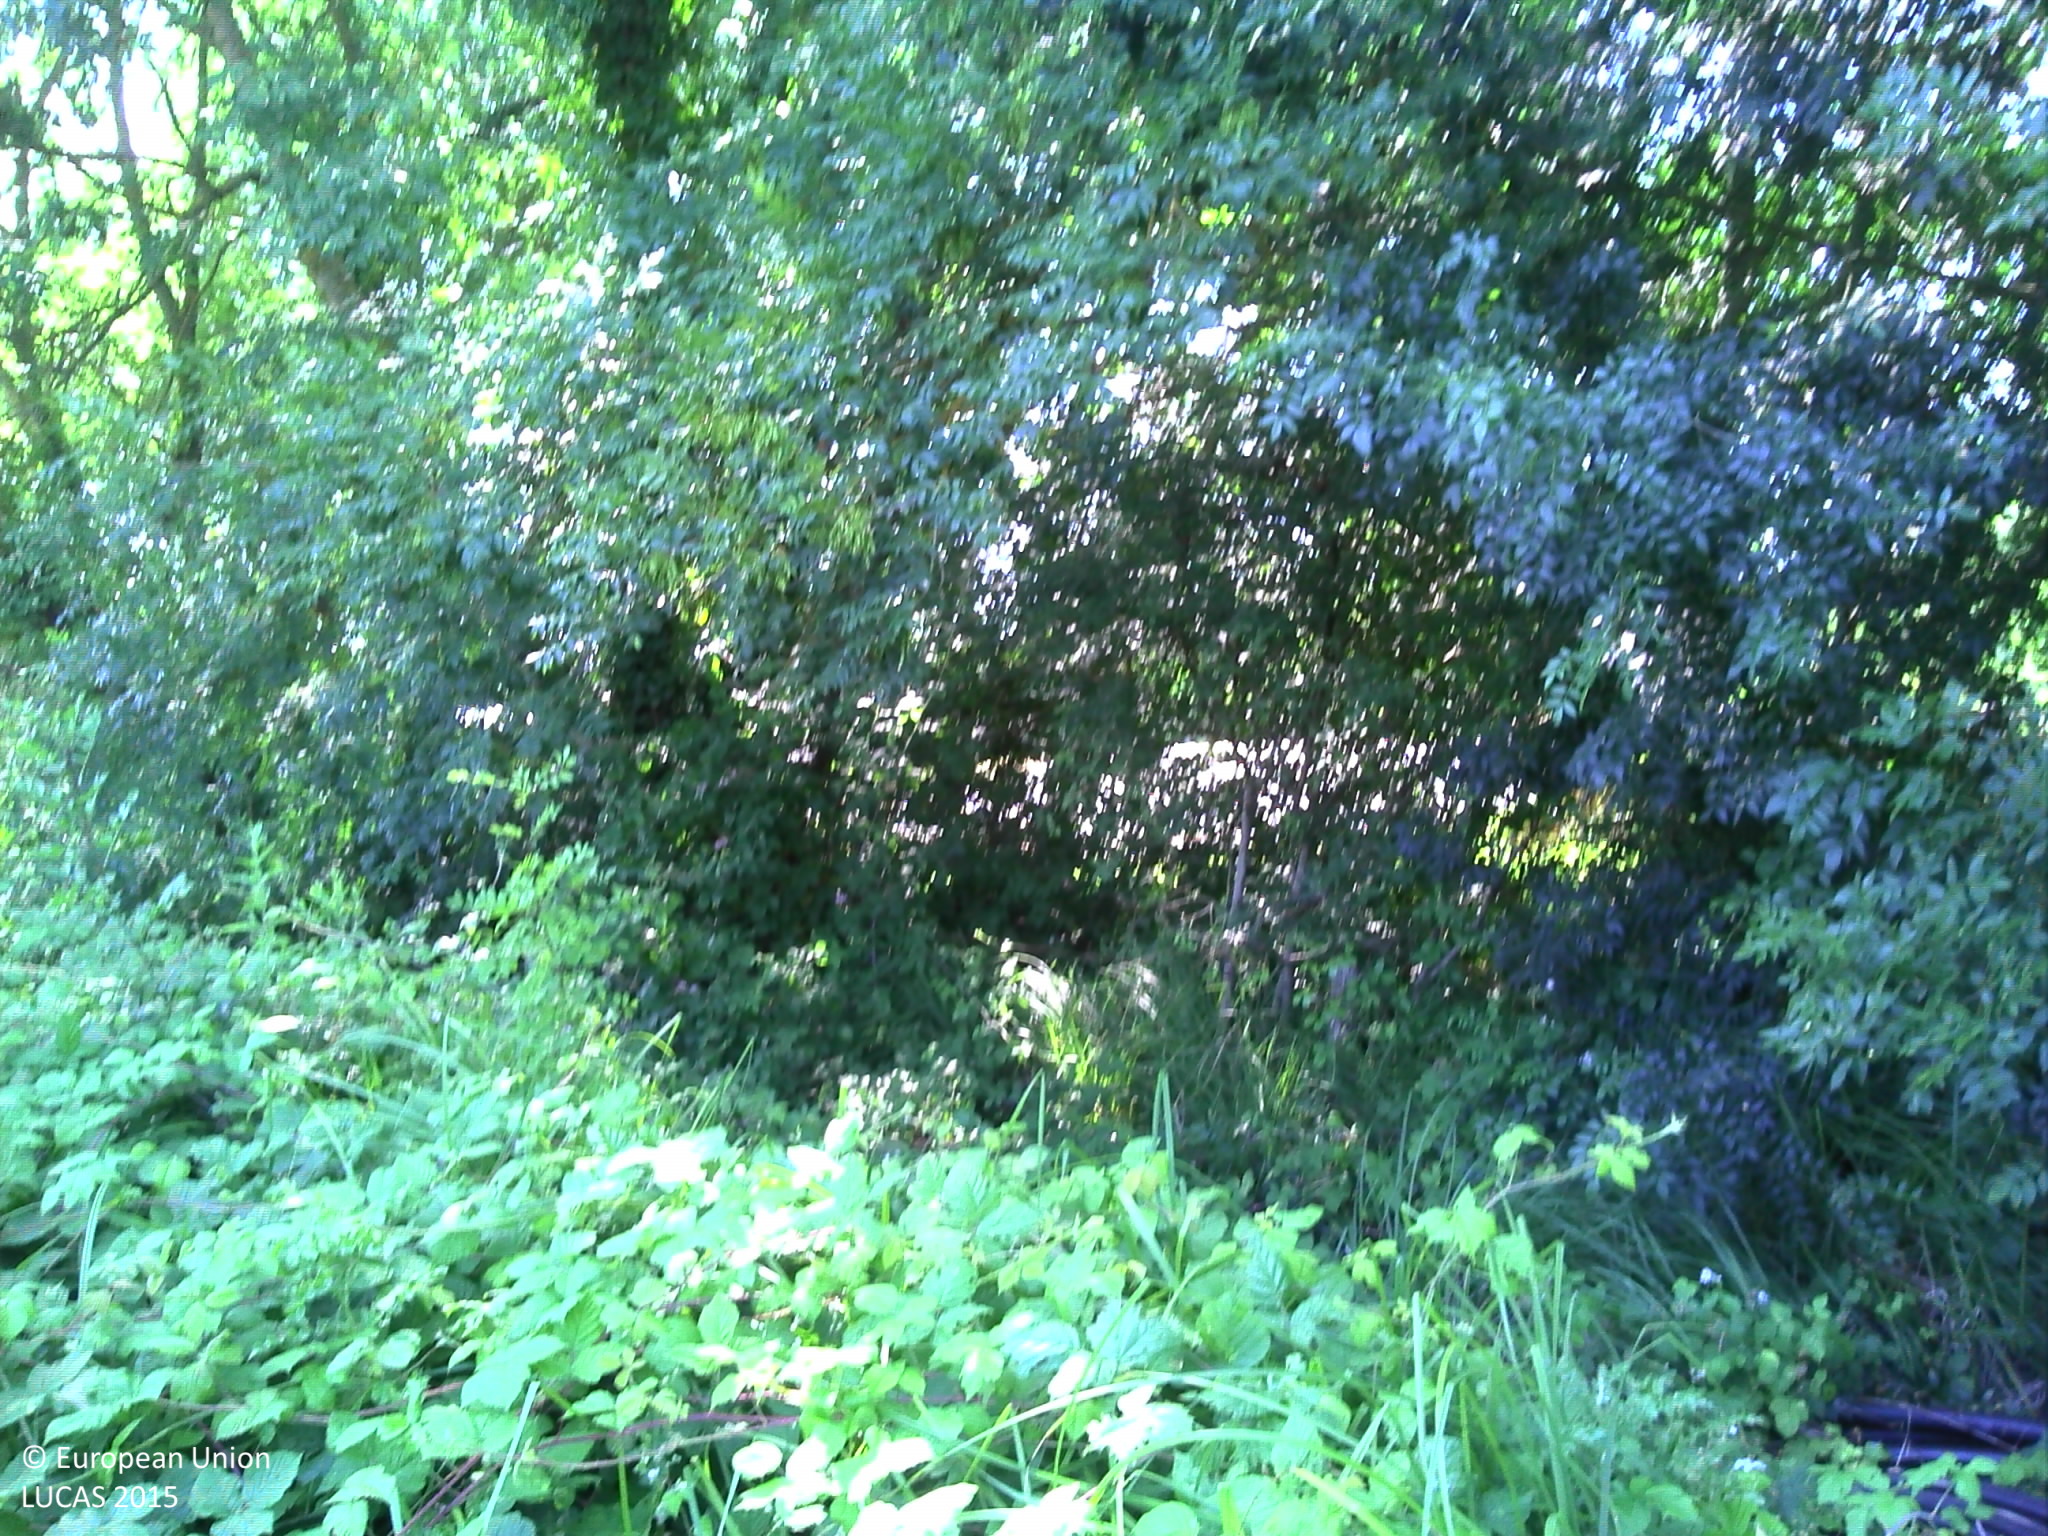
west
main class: Woodland
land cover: Broadleaved woodland
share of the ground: > 75 %
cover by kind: herbaceous plants 70 %, broadleaved forest trees 30 %
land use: Semi-natural and natural areas not in use
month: July
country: FR
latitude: 47.7100
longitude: -0.0367
